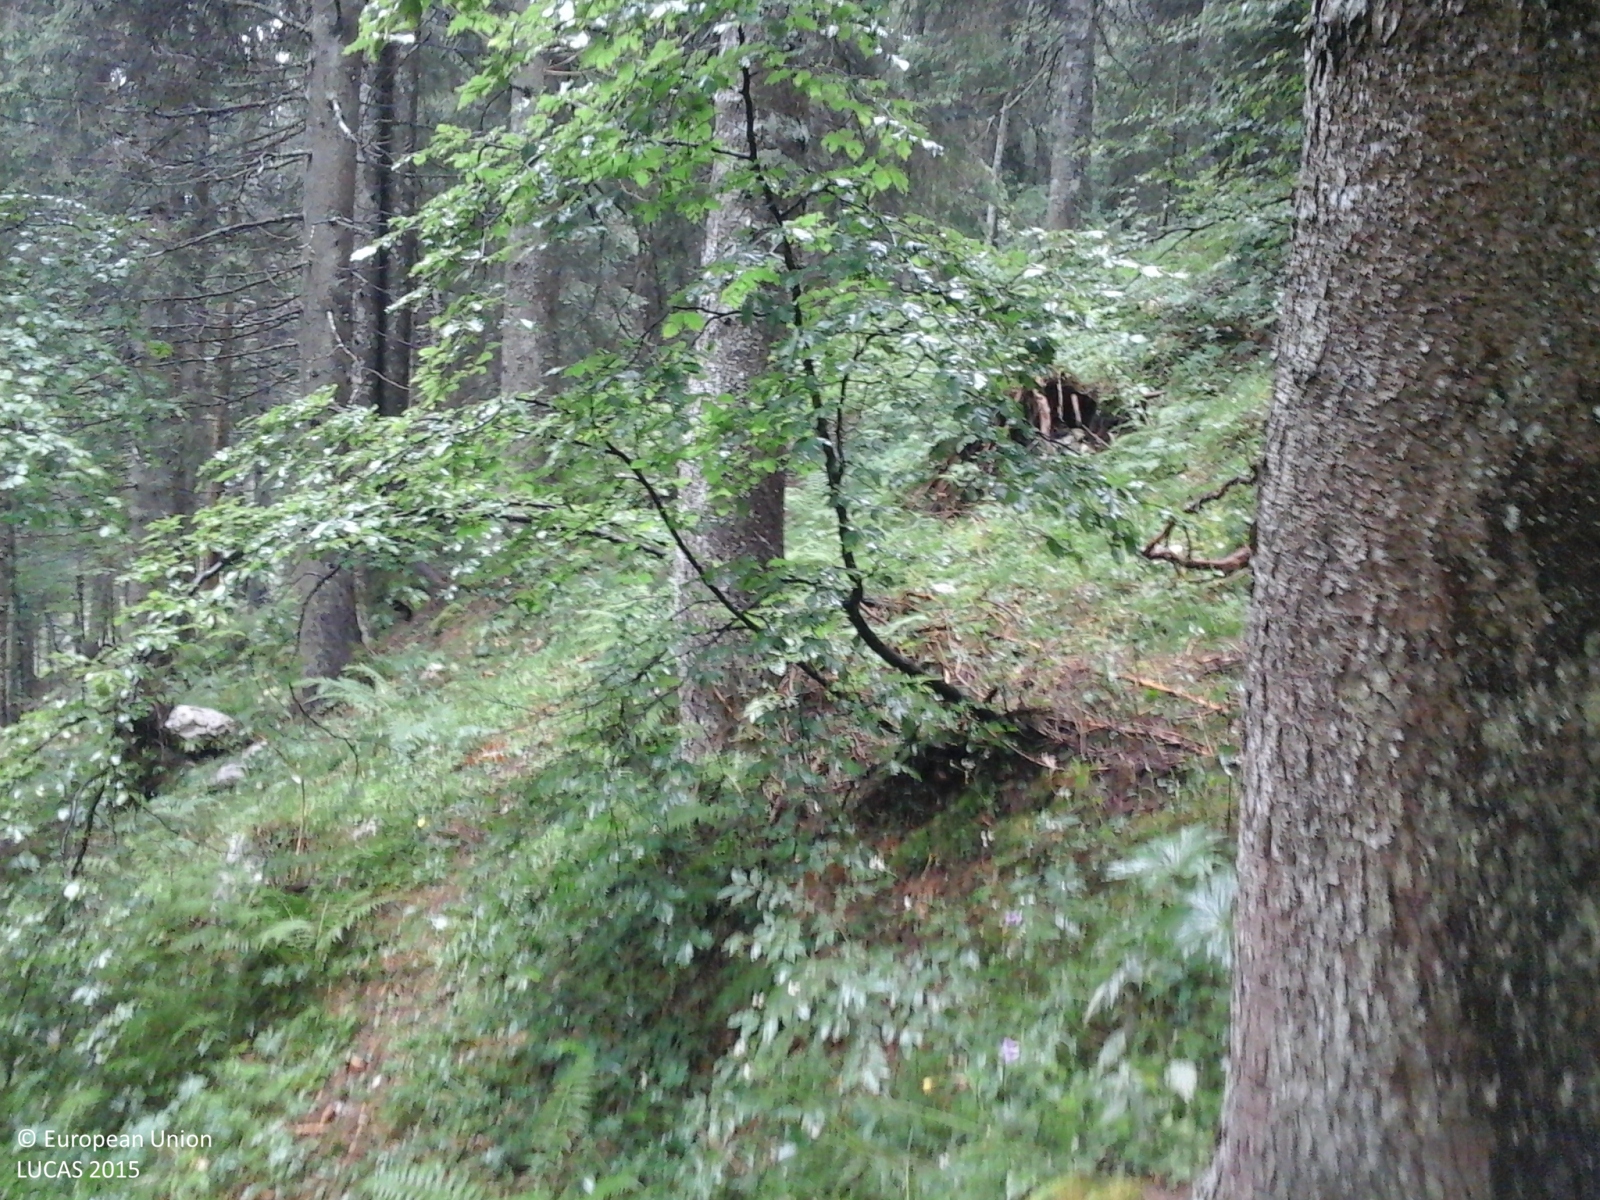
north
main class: Woodland
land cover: Spruce dominated coniferous woodland
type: alpine coniferous forest
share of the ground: > 75 %
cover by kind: coniferous forest trees 100 %
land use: Forestry
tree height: > 5 m
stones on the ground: < 10 %
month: July
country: IT
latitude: 45.8916
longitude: 11.4026
